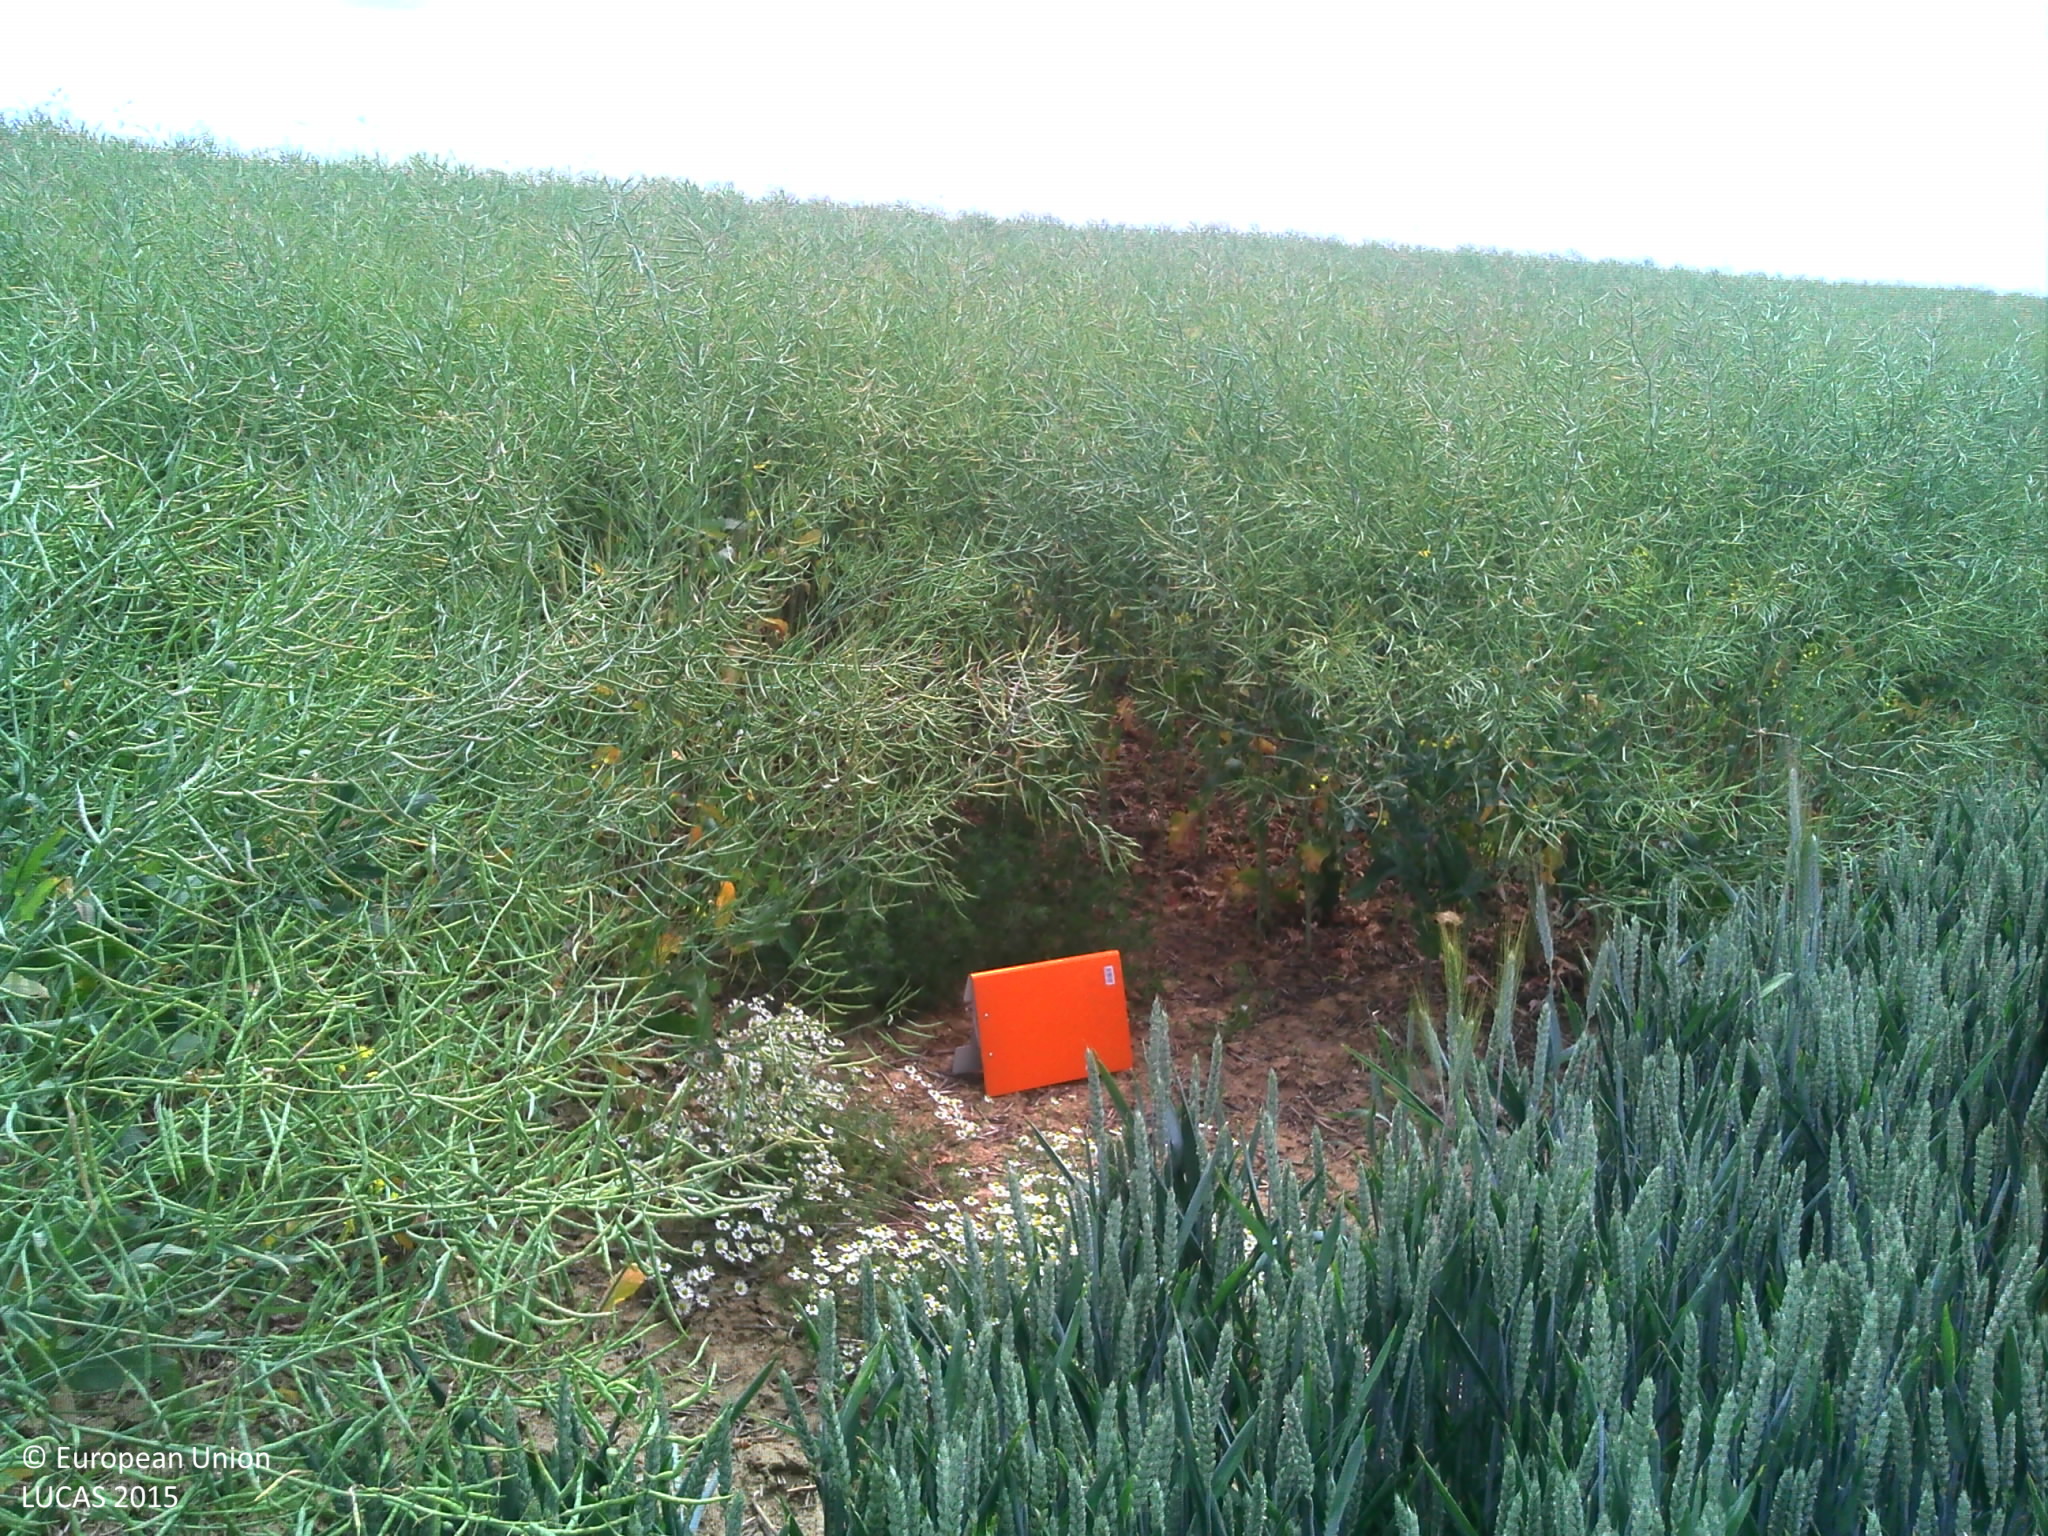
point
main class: Cropland
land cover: Rape and turnip rape
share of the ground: > 75 %
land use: Agriculture (excluding fallow land and kitchen gardens)
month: June
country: FR
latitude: 49.7922
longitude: 4.0075
